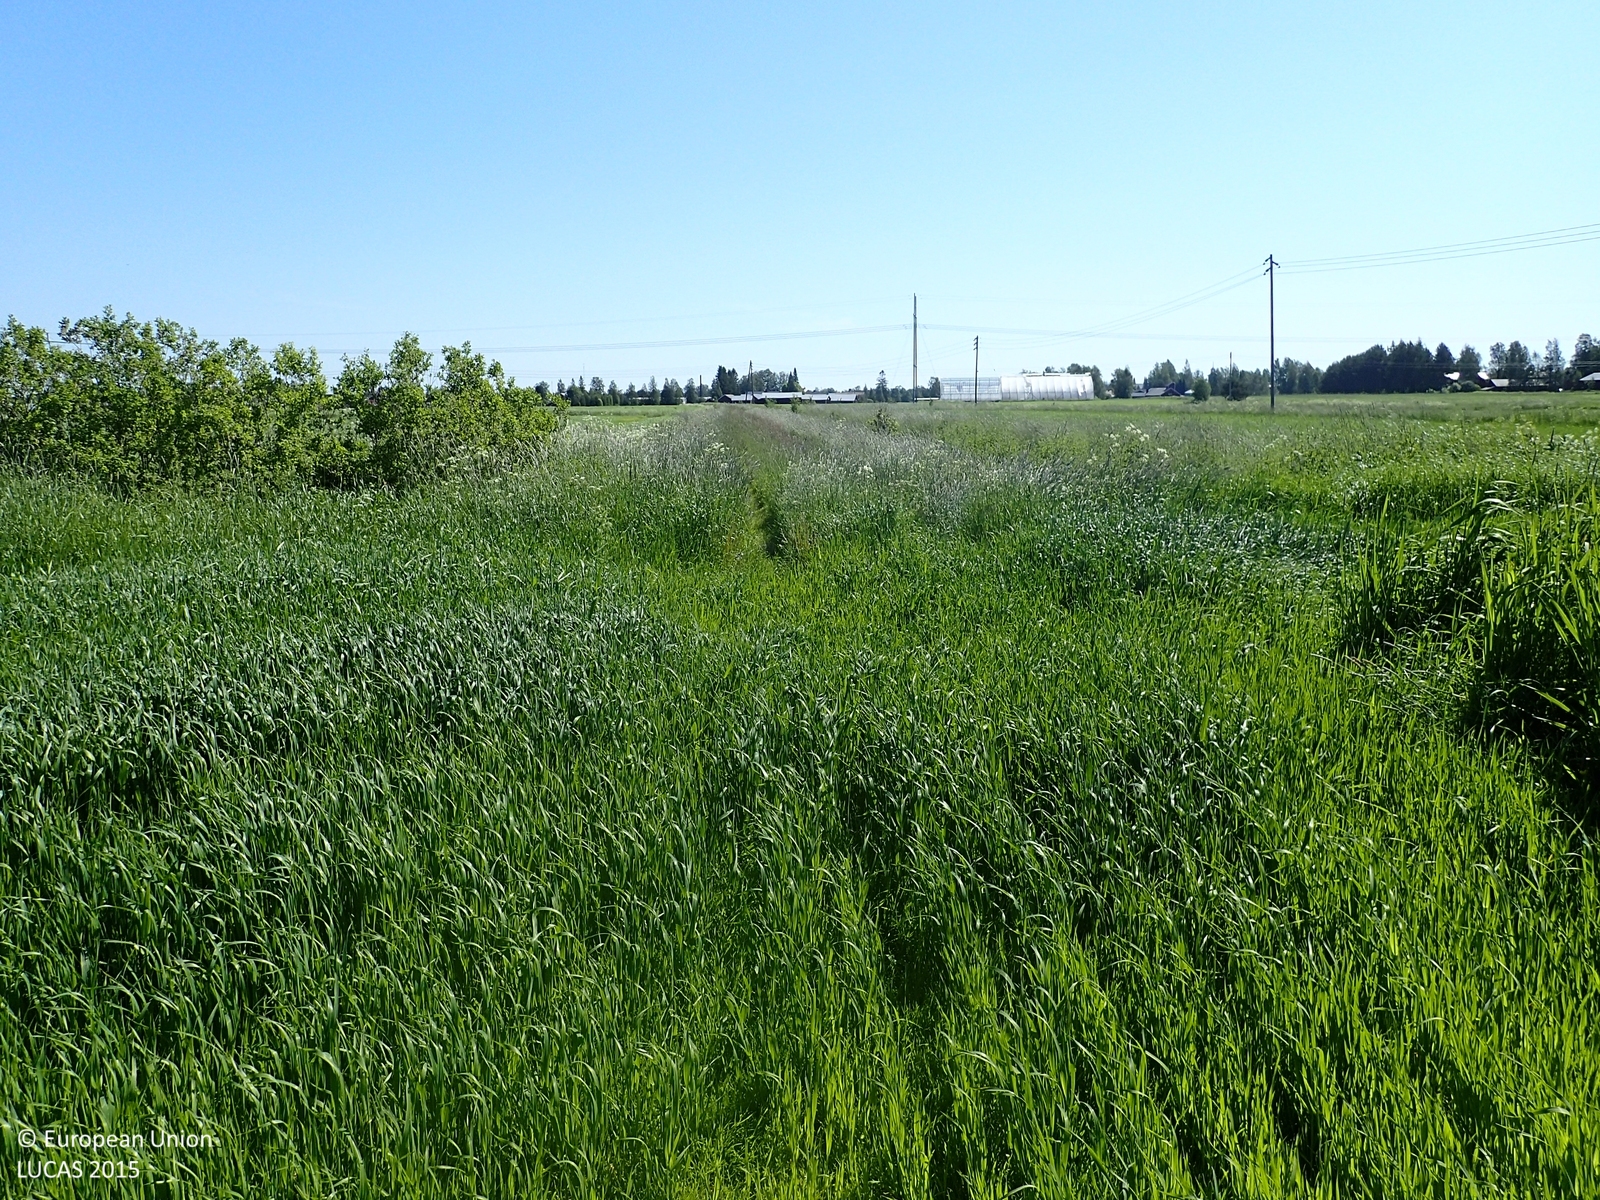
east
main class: Cropland
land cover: Oats
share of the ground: > 75 %
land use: Agriculture (excluding fallow land and kitchen gardens)
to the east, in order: Oats
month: July
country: FI
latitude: 62.6129
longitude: 21.4413
